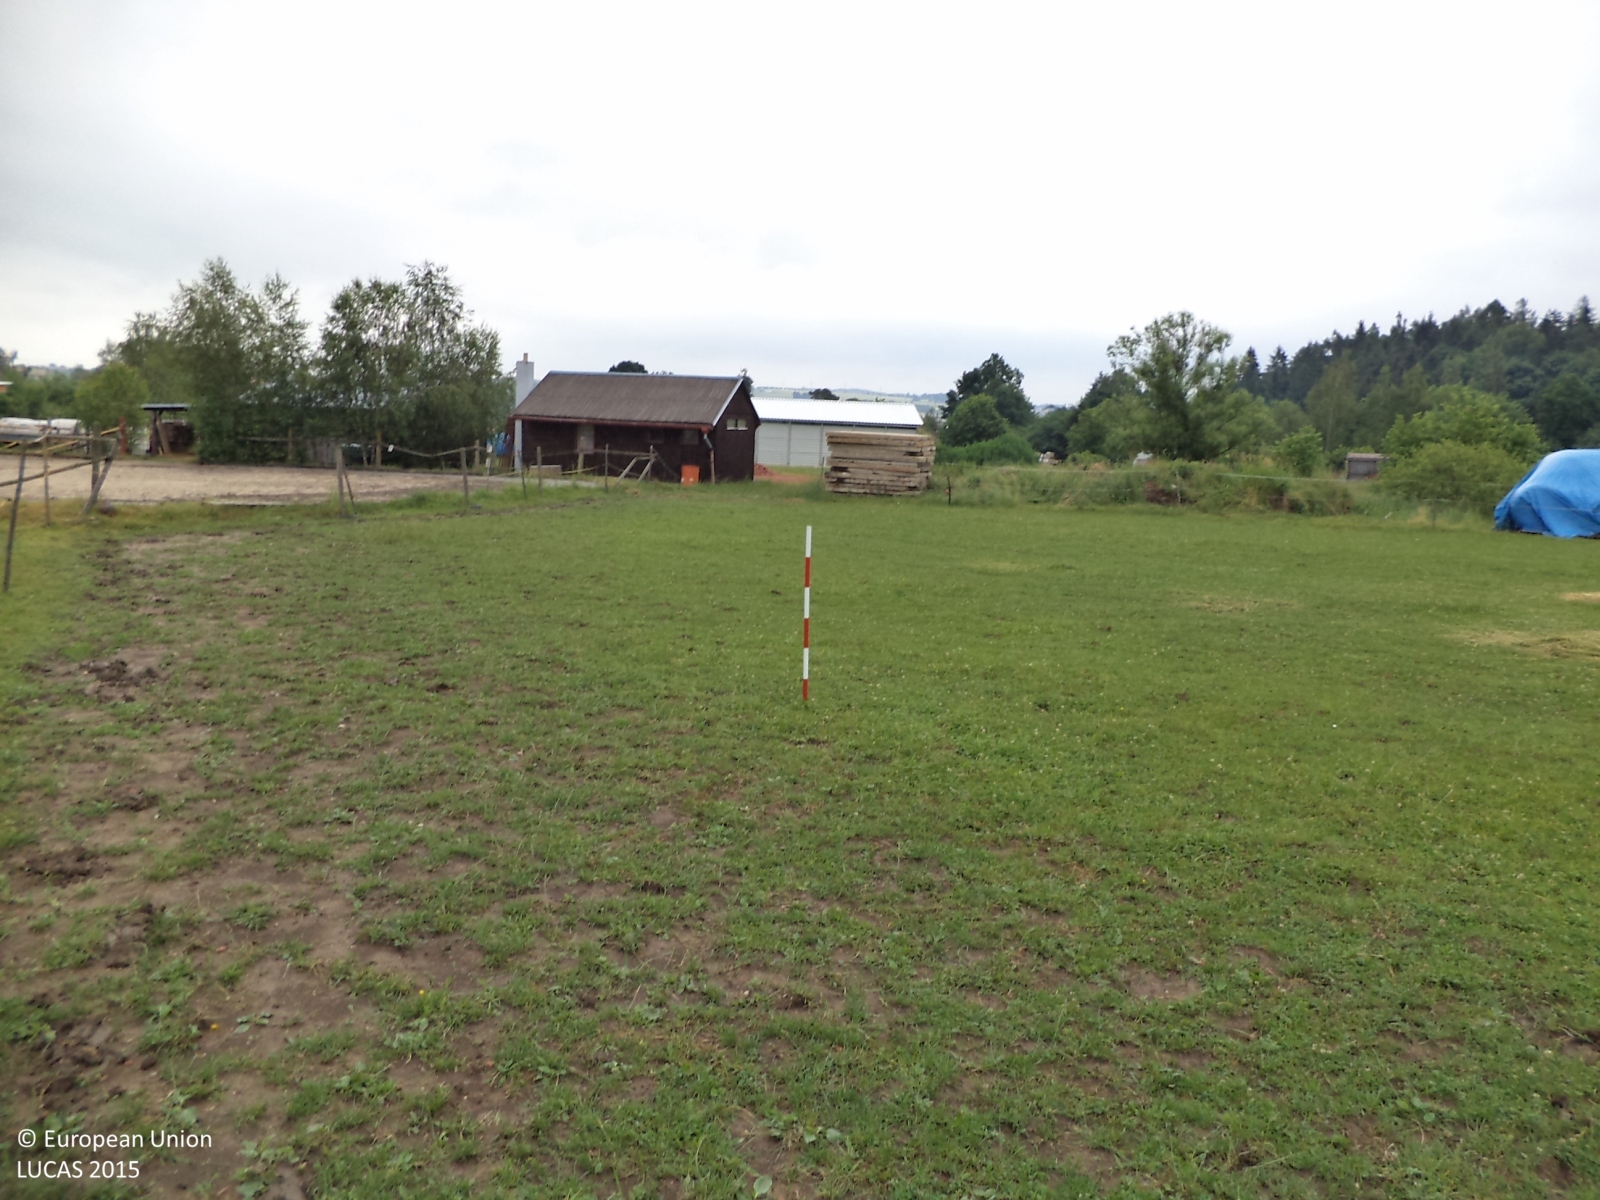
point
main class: Grassland
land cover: Grassland without tree/shrub cover
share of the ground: > 75 %
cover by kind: herbaceous plants 100 %
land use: Agriculture (excluding fallow land and kitchen gardens)
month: June
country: CZ
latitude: 49.2165
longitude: 14.4080
